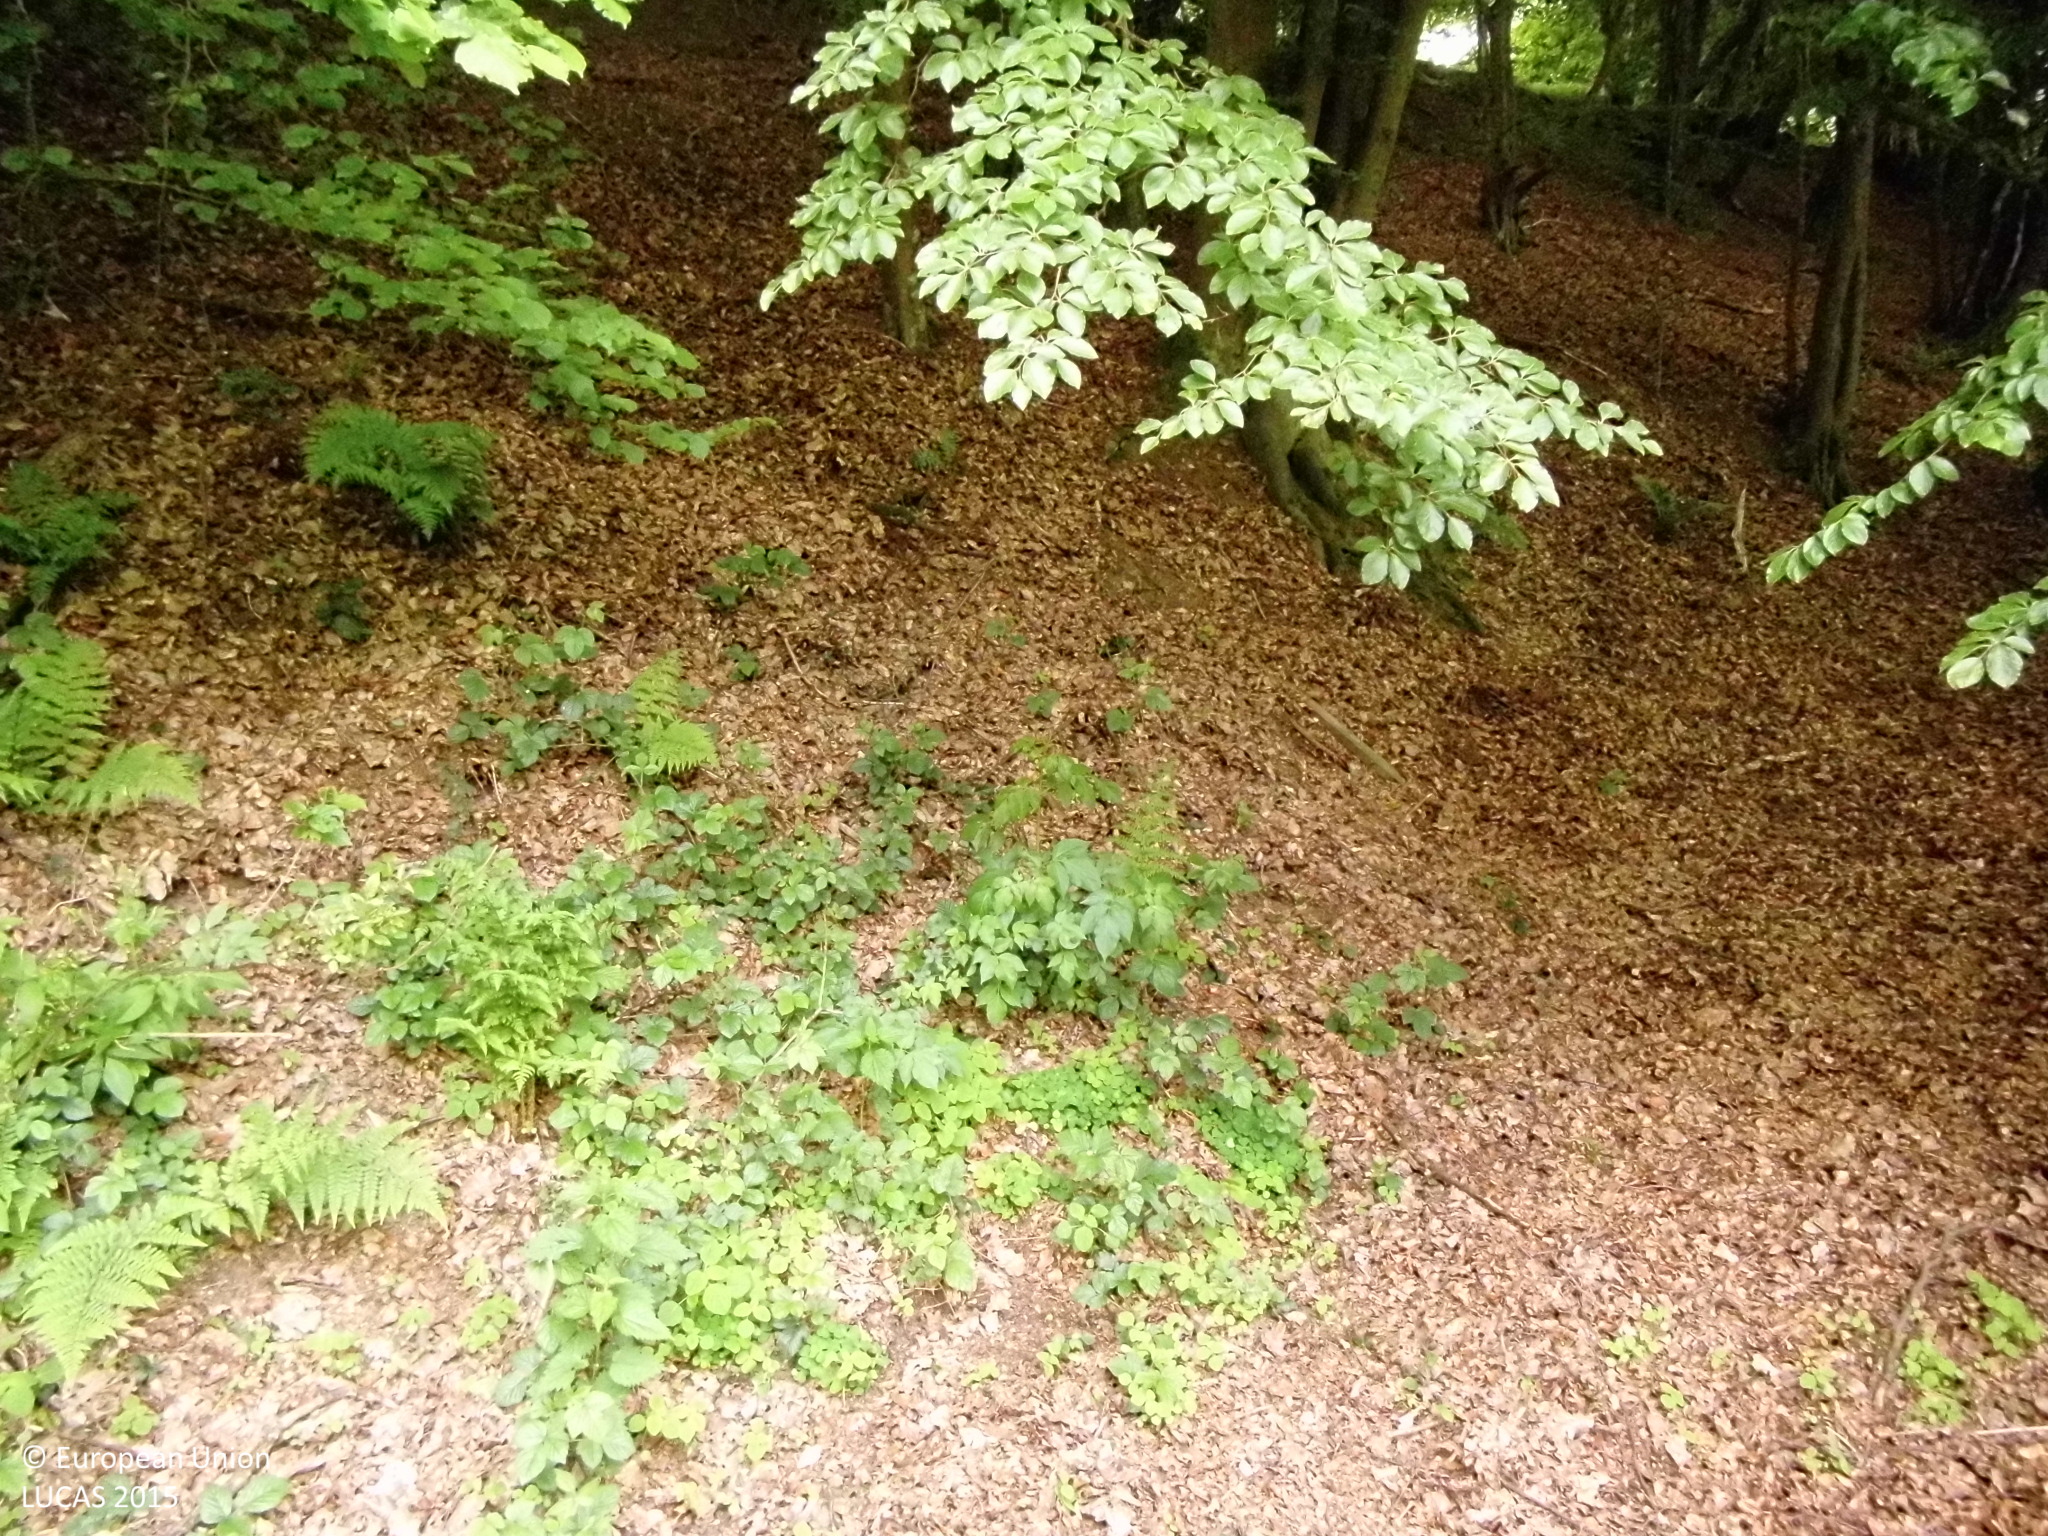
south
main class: Grassland
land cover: Grassland with sparse tree/shrub cover
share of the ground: > 75 %
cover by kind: herbaceous plants 95 %, broadleaved forest trees 5 %
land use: Amenities, museums, leisure
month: May
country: DE
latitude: 50.5712
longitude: 7.5293
